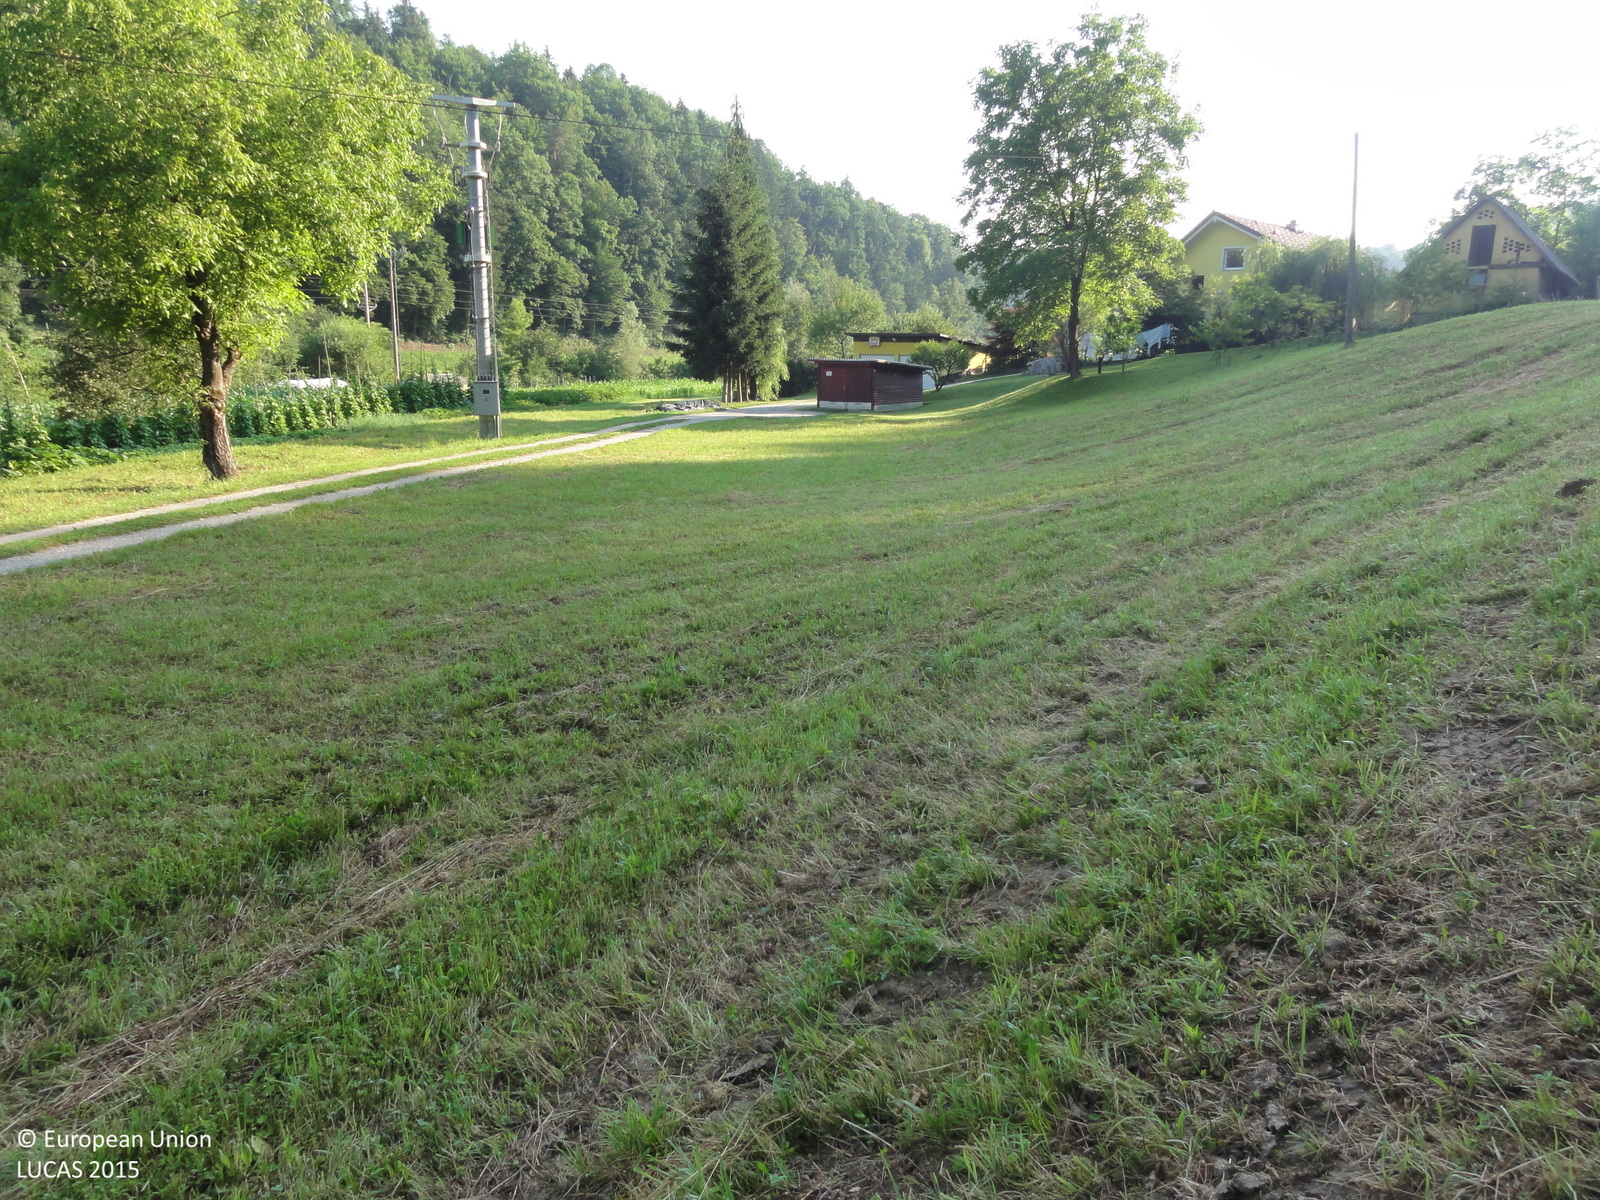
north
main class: Grassland
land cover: Grassland without tree/shrub cover
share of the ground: > 75 %
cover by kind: herbaceous plants 100 %
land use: Agriculture (excluding fallow land and kitchen gardens)
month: July
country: SI
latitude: 46.6389
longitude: 15.5773
